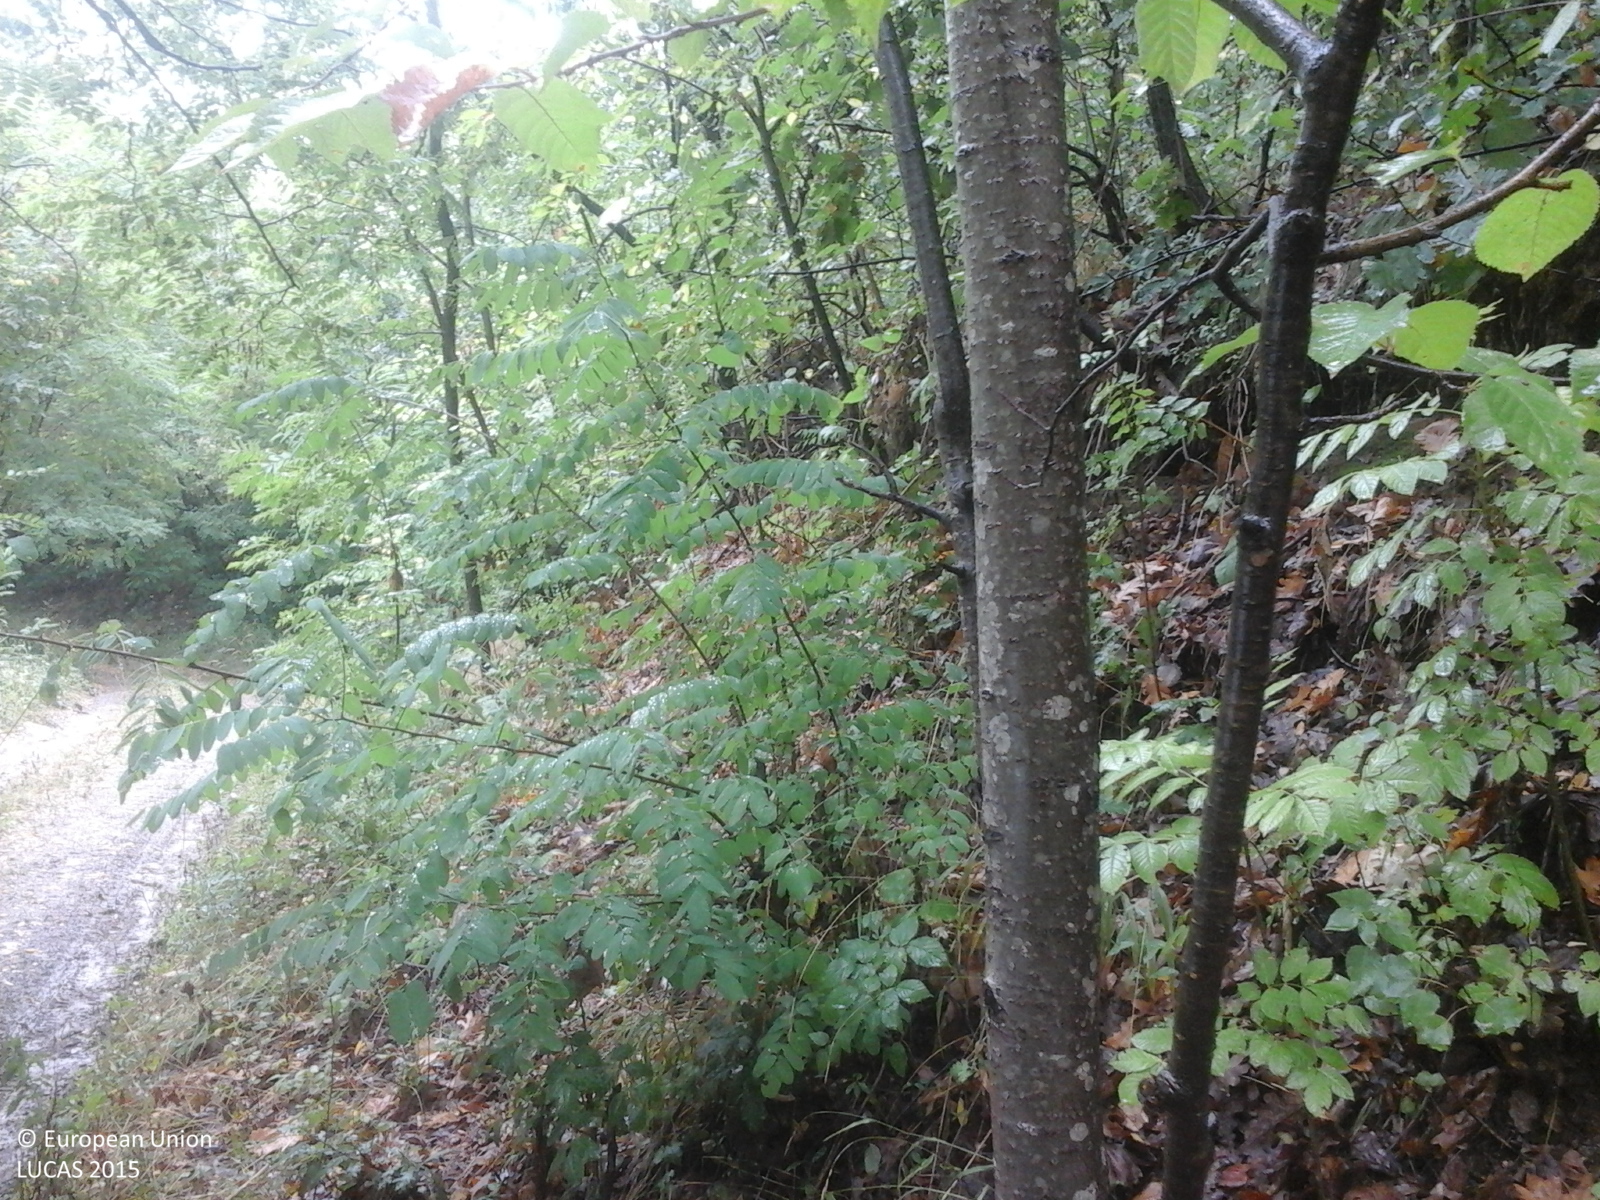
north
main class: Woodland
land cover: Broadleaved woodland
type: mesophytic deciduous forest
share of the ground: > 75 %
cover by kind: broadleaved forest trees 100 %
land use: Forestry
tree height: > 5 m
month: August
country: RO
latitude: 44.9673
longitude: 22.1193
